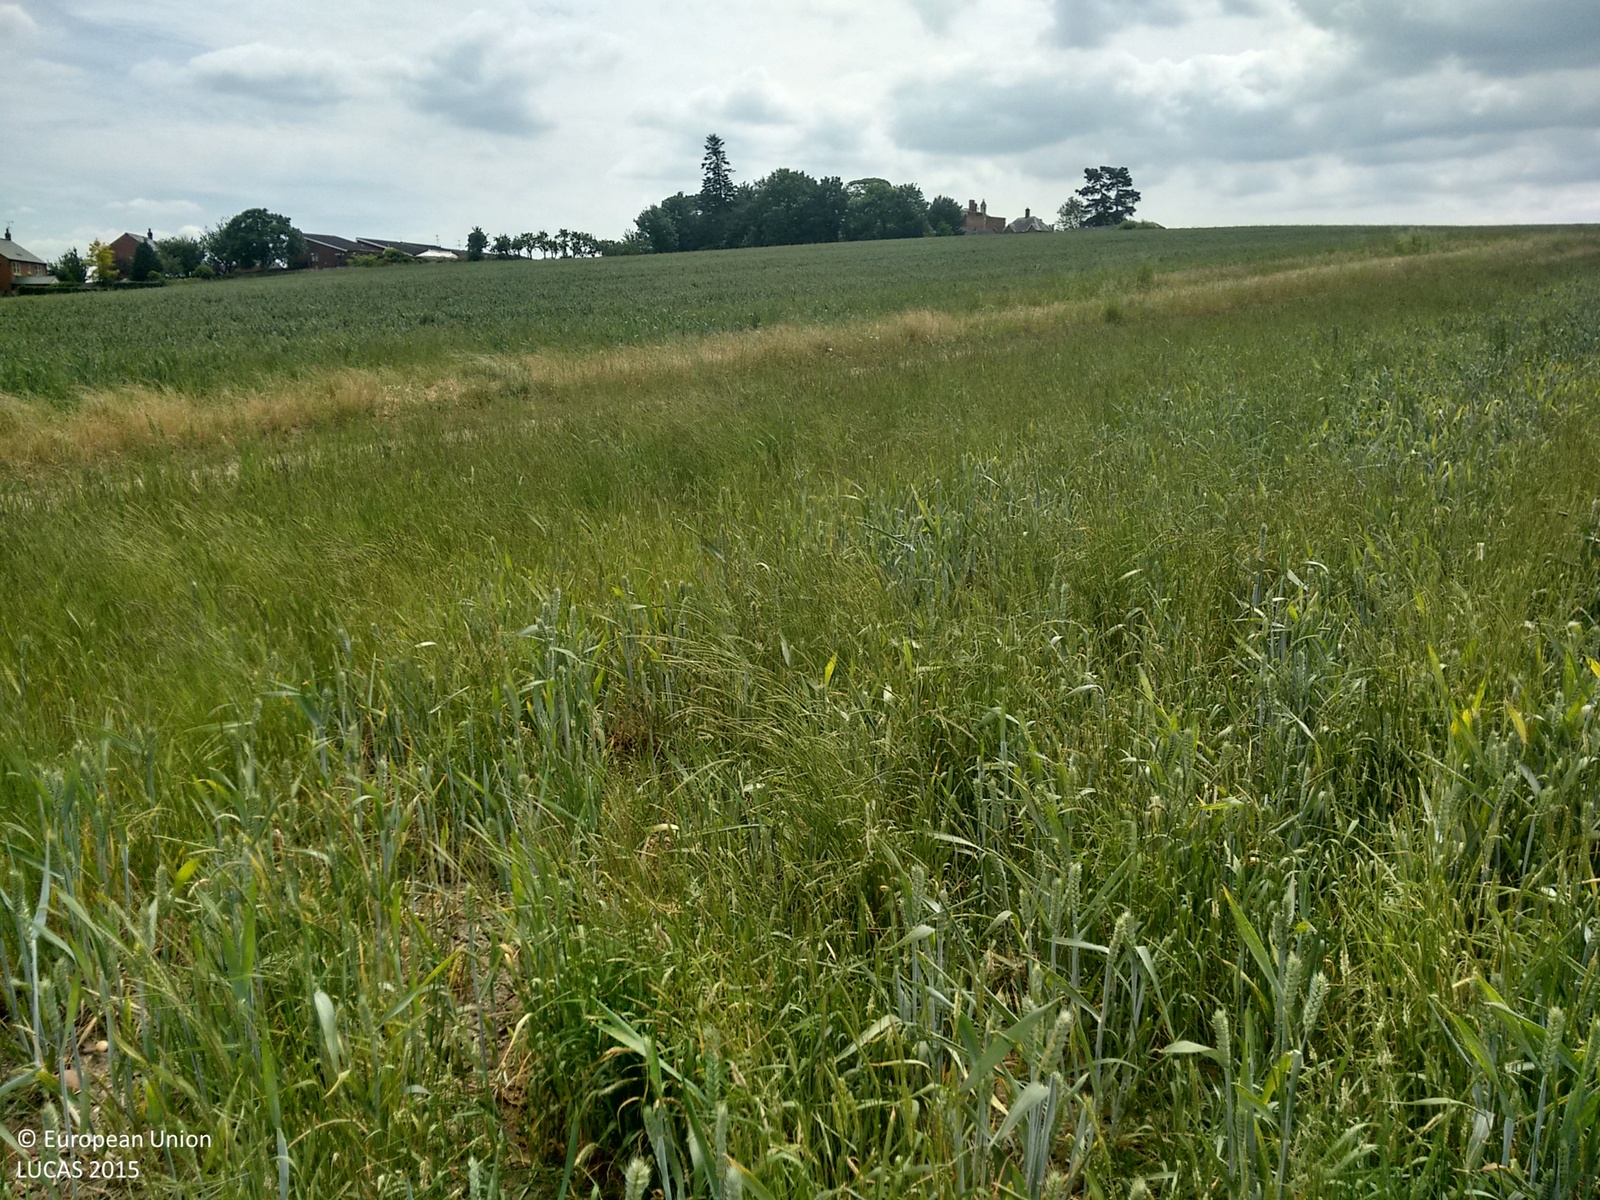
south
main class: Cropland
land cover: Common wheat
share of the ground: > 75 %
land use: Agriculture (excluding fallow land and kitchen gardens)
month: June
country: GB
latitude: 52.1215
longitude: -2.0800
